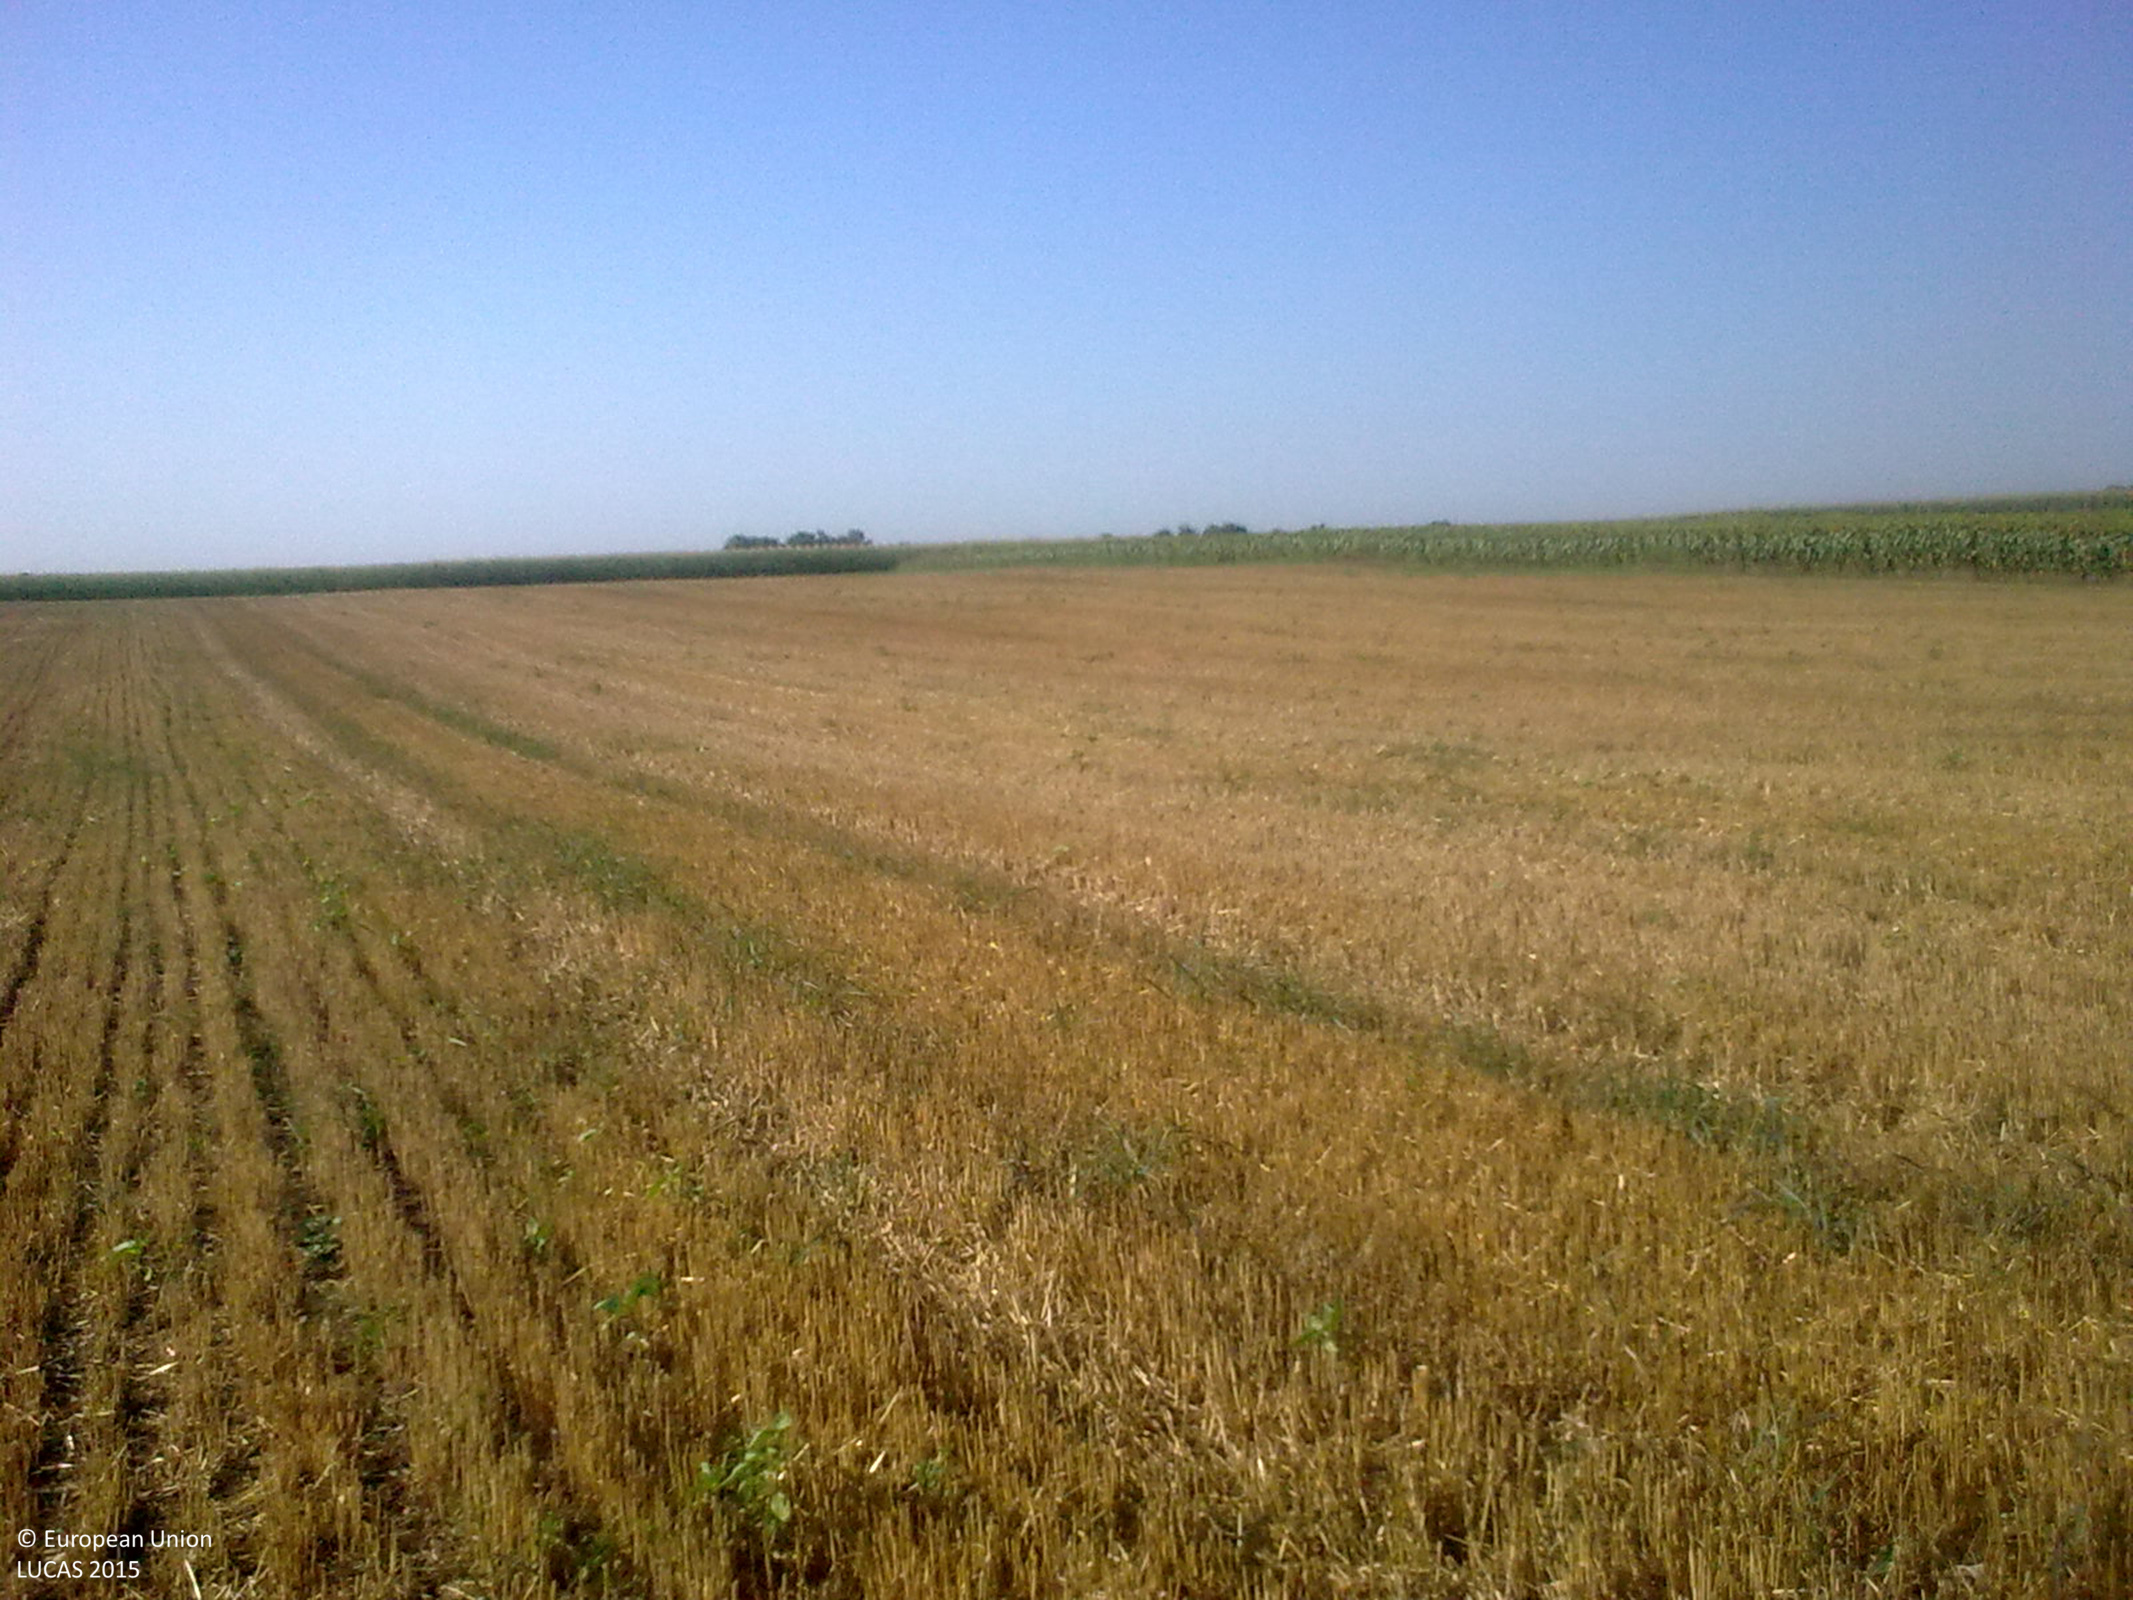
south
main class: Cropland
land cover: Common wheat
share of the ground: 50 - 75 %
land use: Agriculture (excluding fallow land and kitchen gardens)
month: July
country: BG
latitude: 43.9722
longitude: 26.1693
